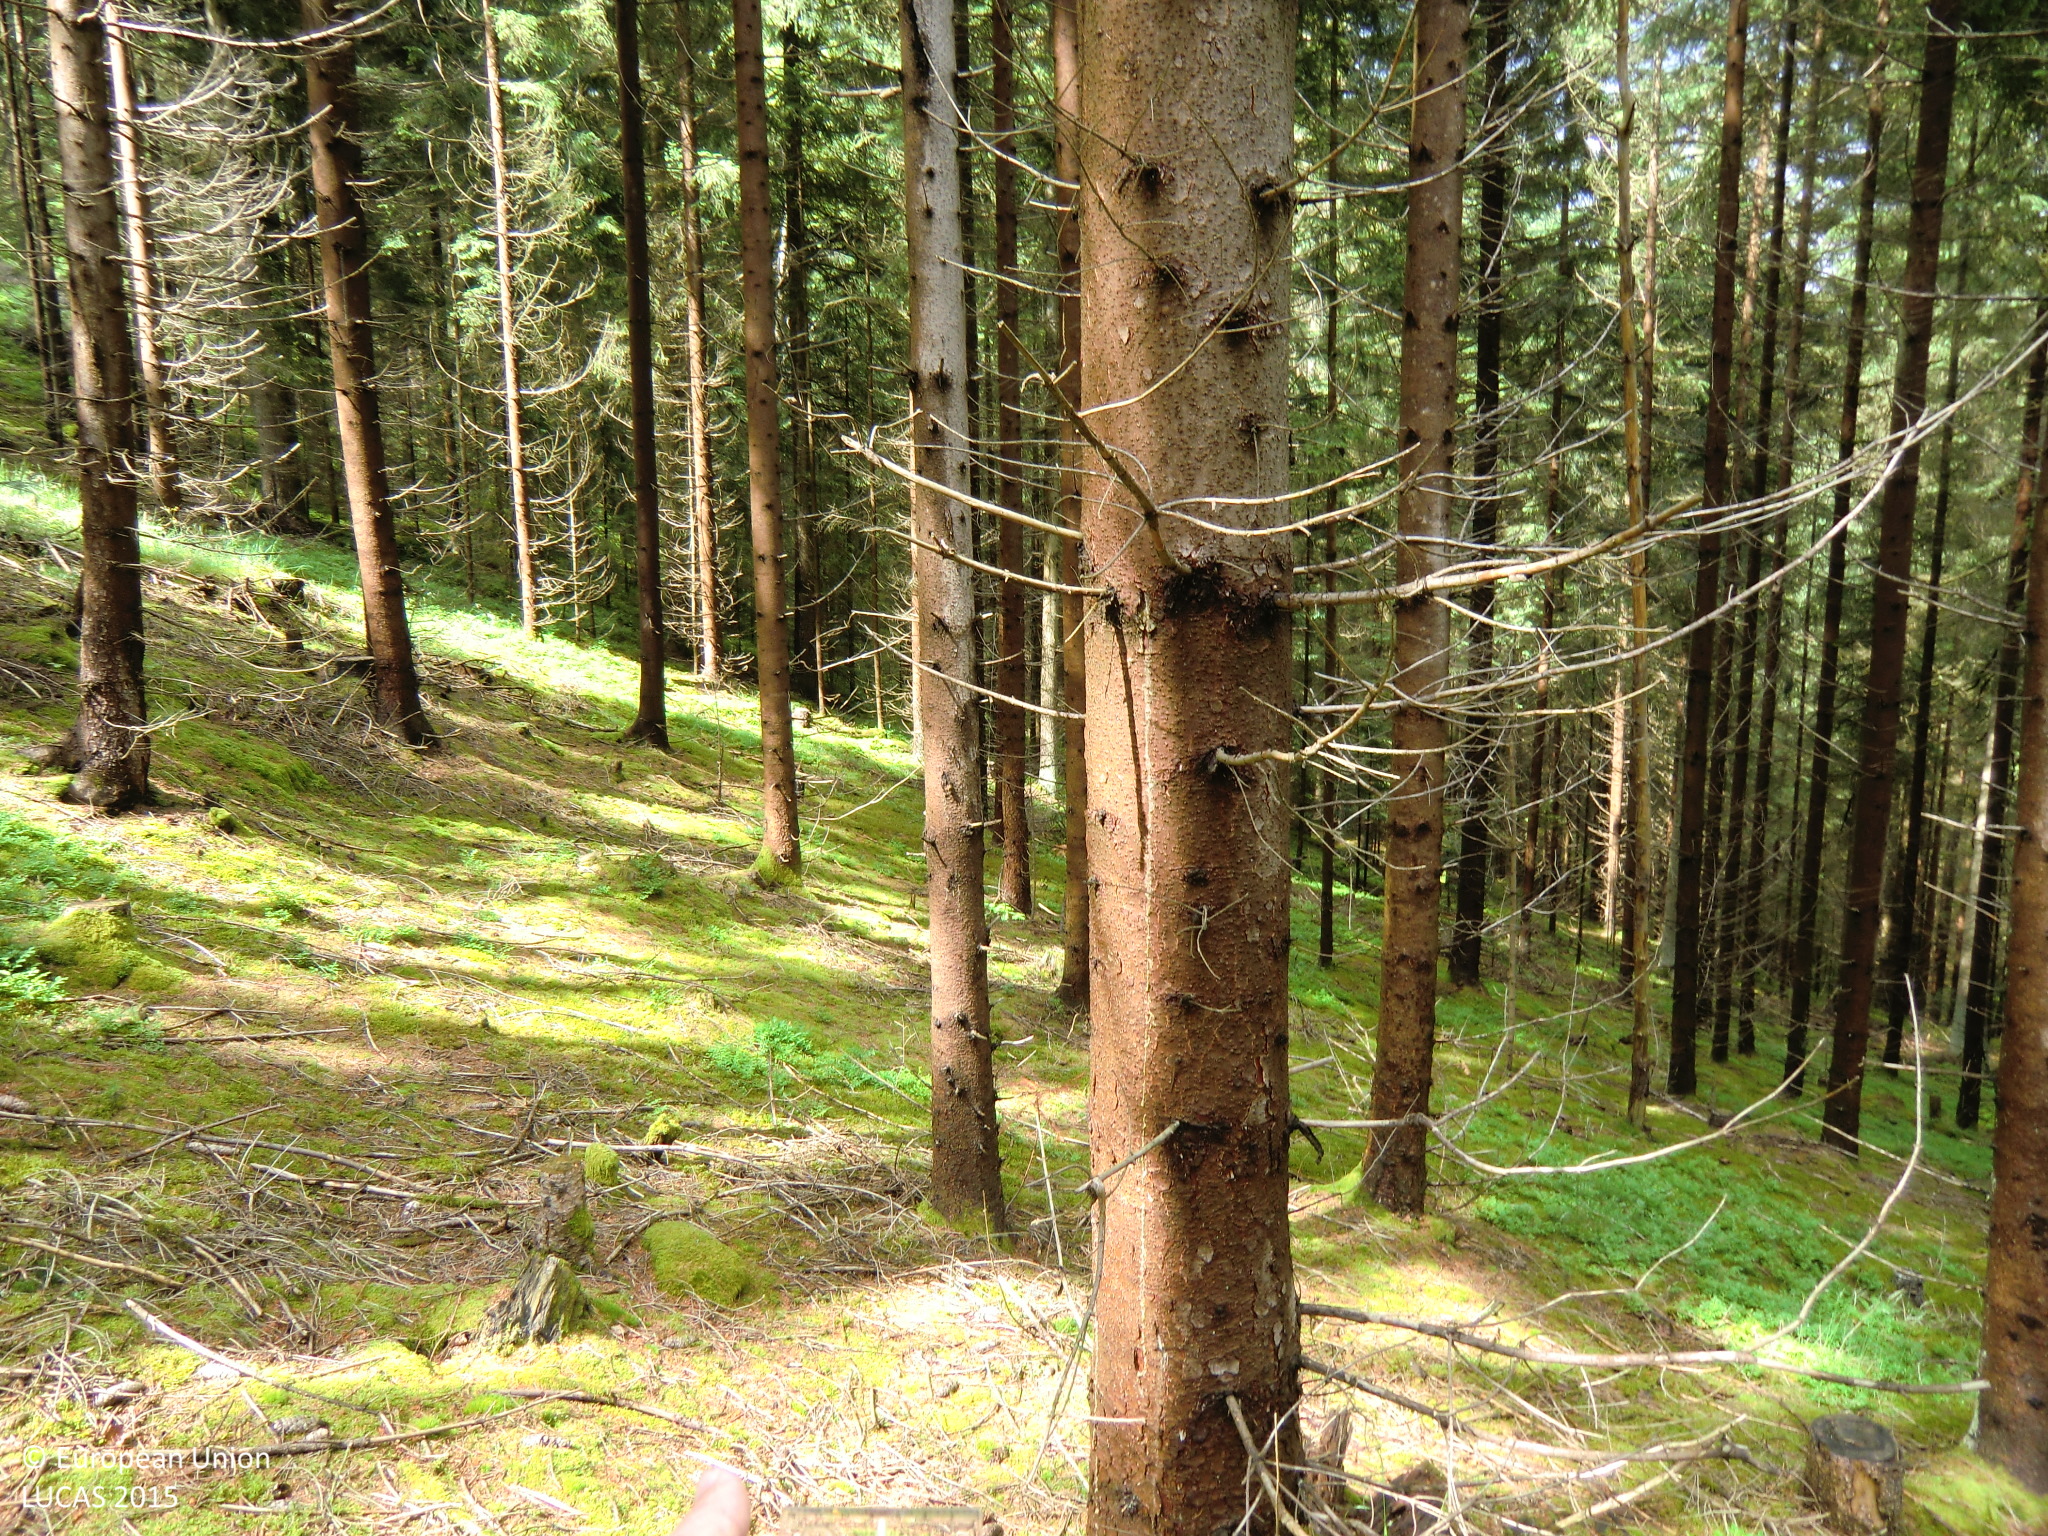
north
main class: Woodland
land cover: Spruce dominated coniferous woodland
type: hemiboreal forest and nemoral coniferous forest and mixed broadleaved-coniferous forest
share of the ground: > 75 %
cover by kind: coniferous forest trees 75 %, lichens and mosses 15 %, herbaceous plants 10 %
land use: Forestry
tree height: > 5 m
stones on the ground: 10 - 25 %
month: June
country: AT
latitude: 48.4302
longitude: 14.6907
